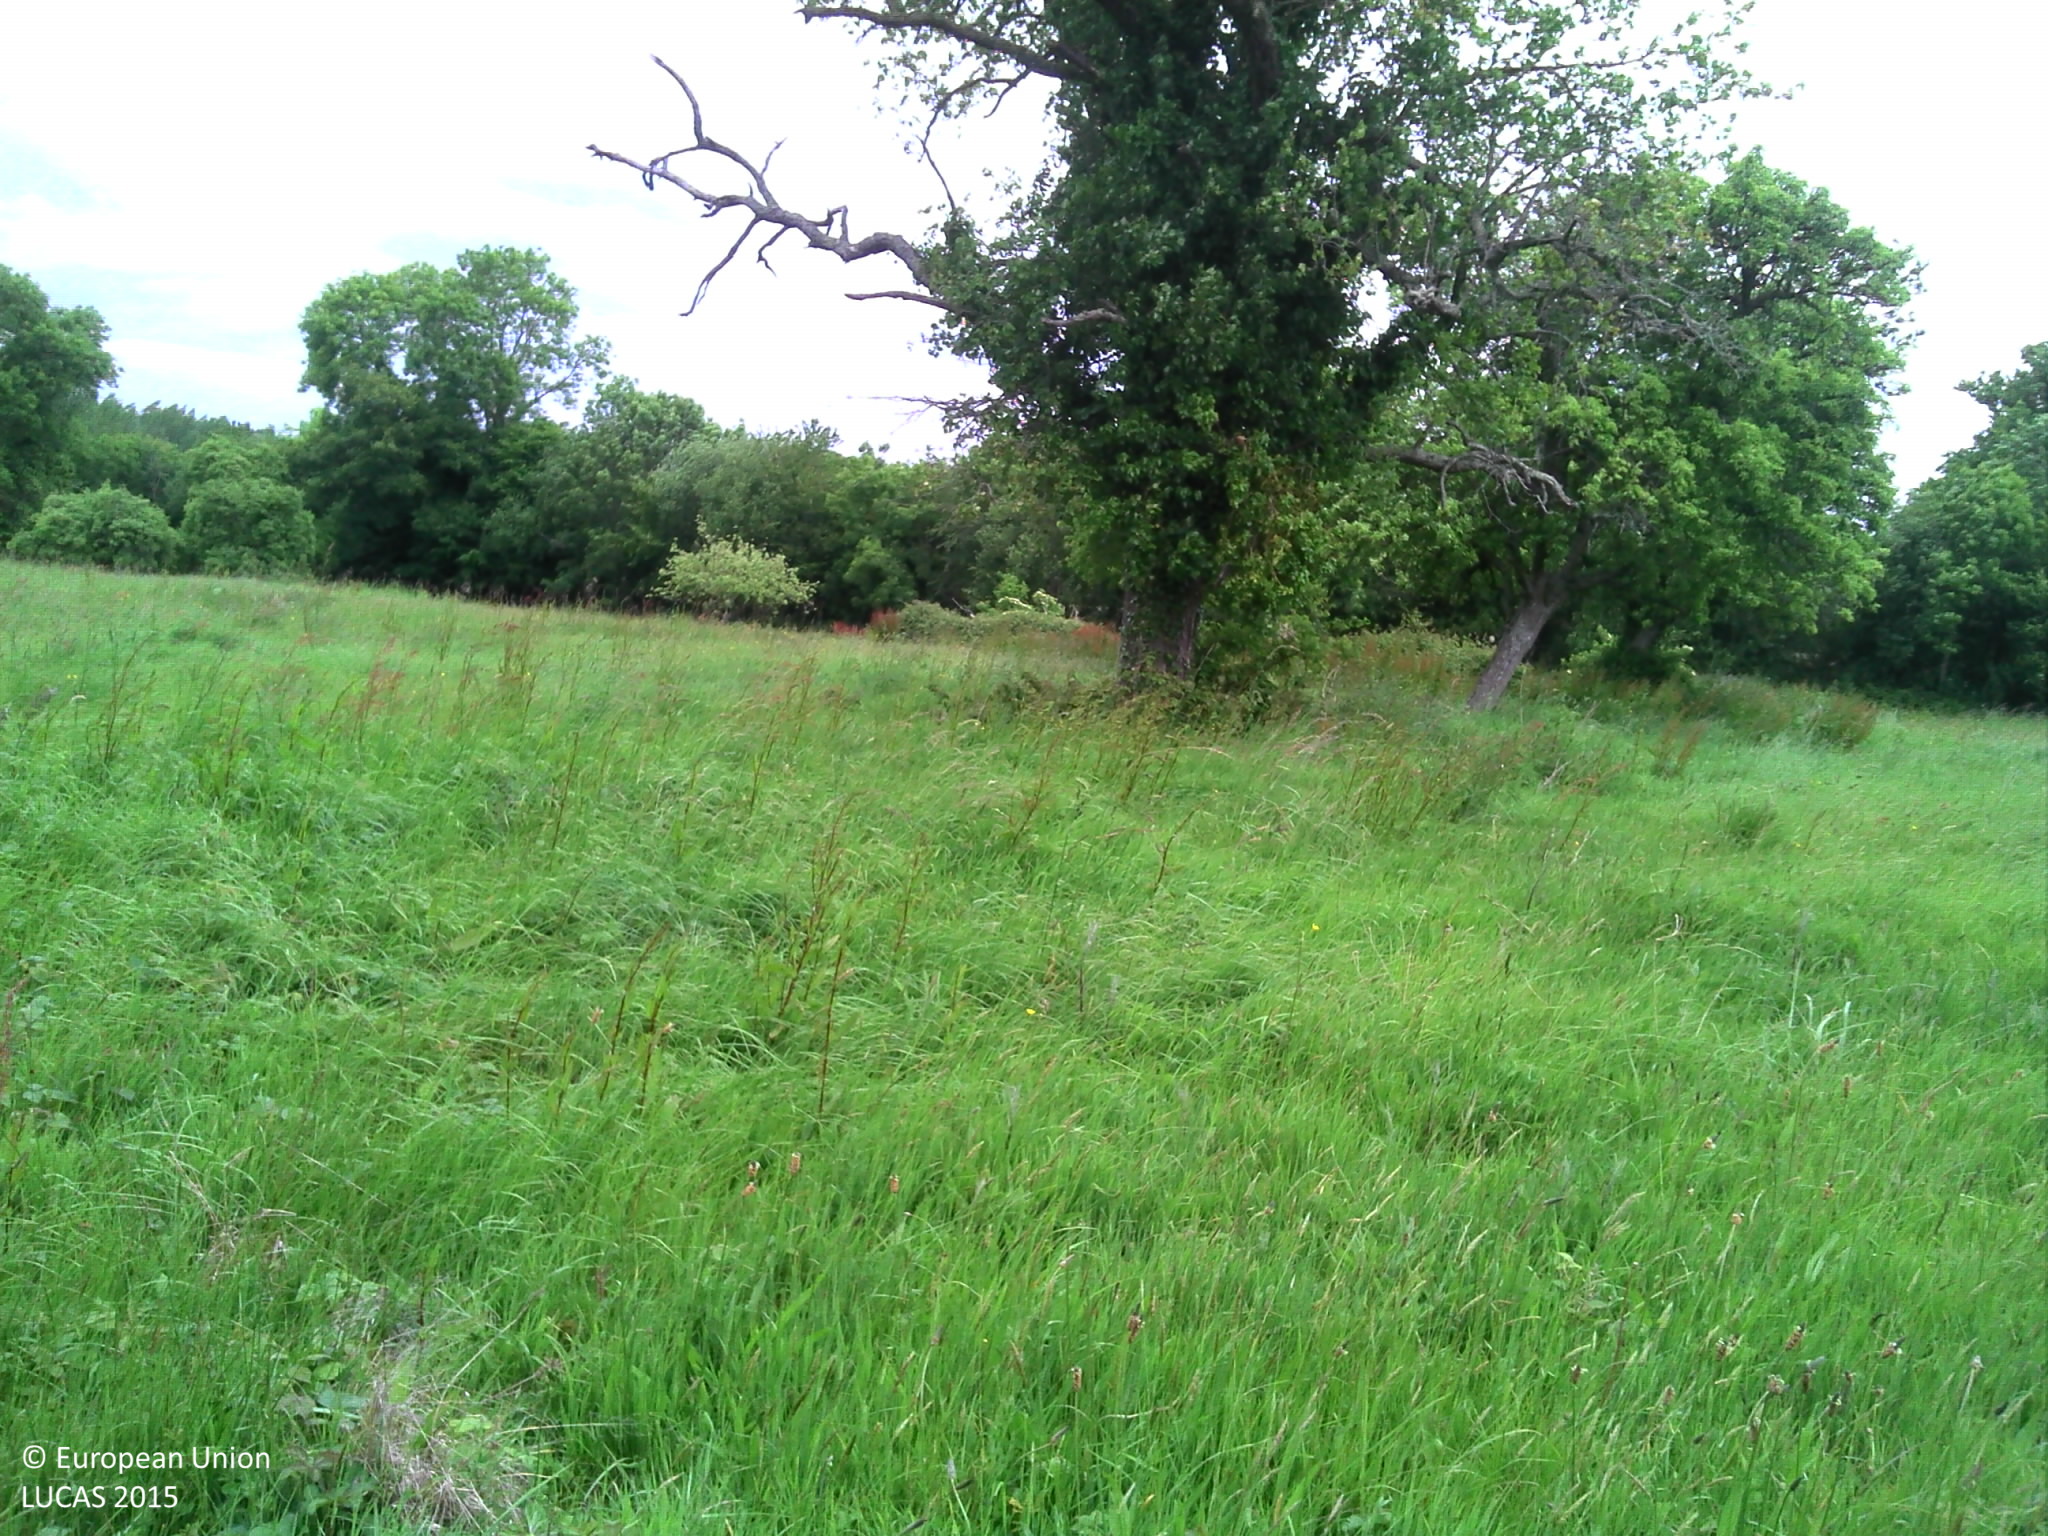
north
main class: Cropland
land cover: Pear fruit
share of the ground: < 10 %
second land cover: Grassland without tree/shrub cover
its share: > 75 %
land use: Agriculture (excluding fallow land and kitchen gardens)
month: May
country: FR
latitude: 49.2905
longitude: 0.0006
